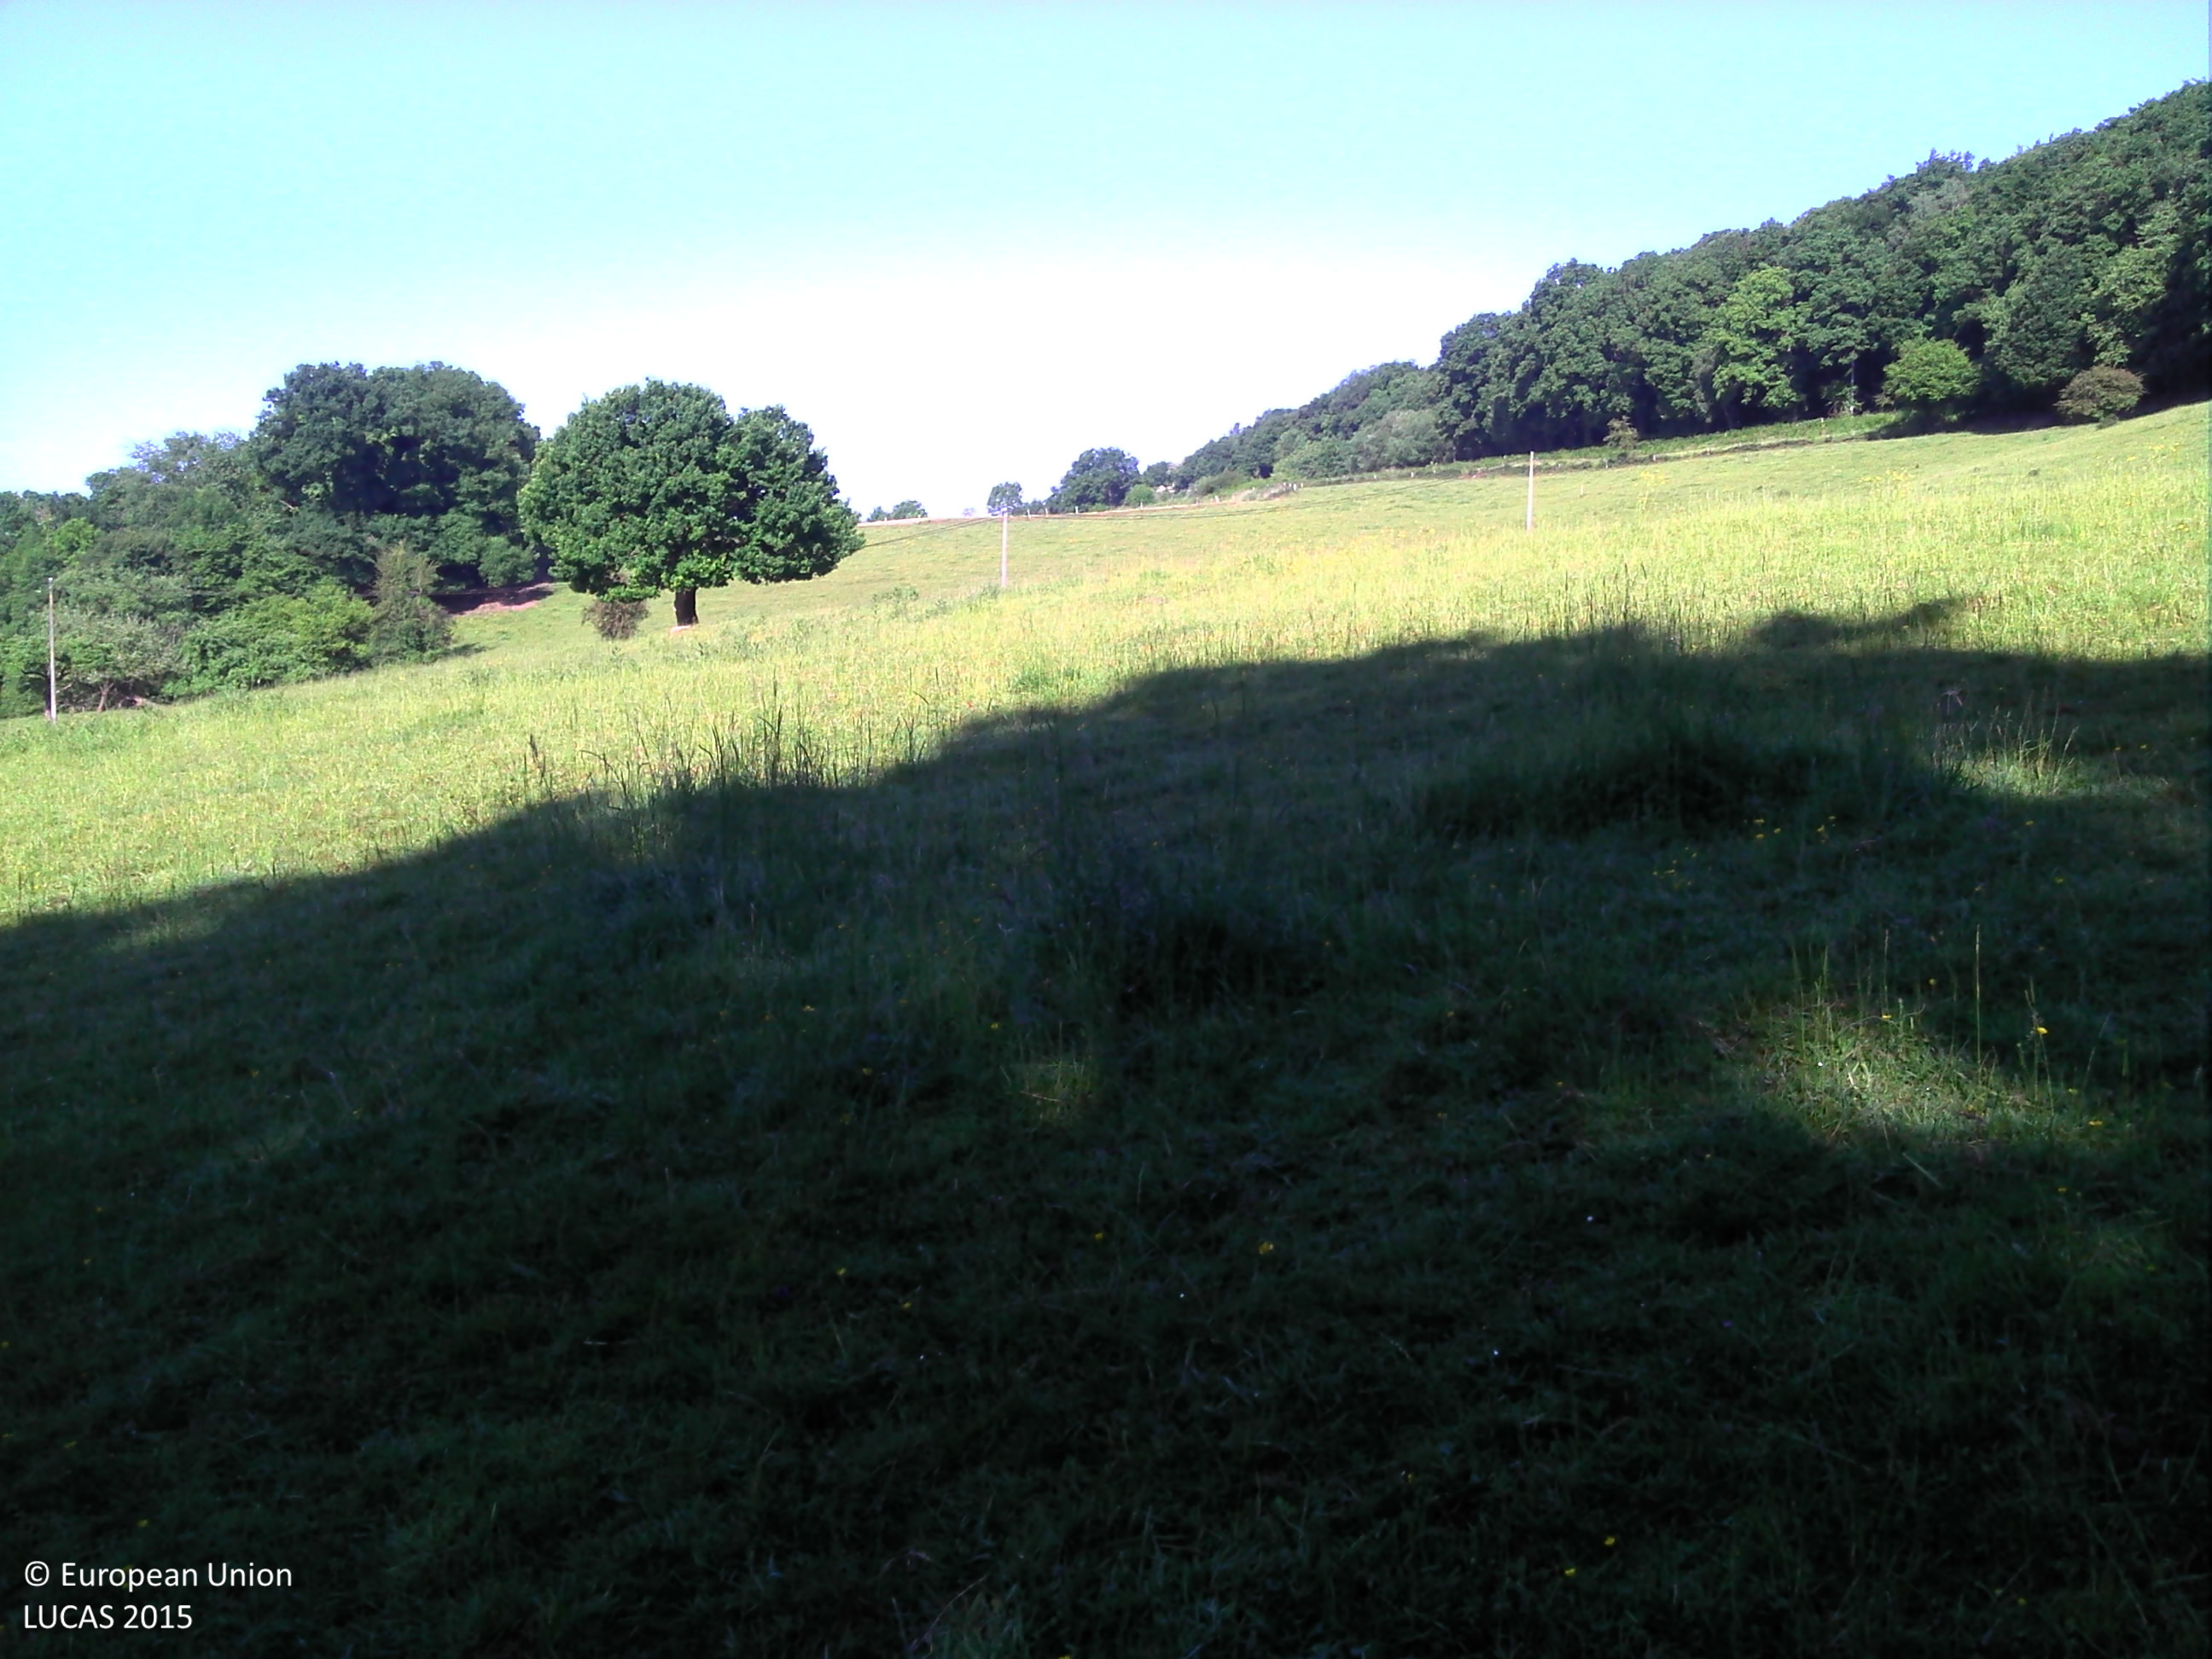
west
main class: Grassland
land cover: Grassland without tree/shrub cover
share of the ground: > 75 %
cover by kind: herbaceous plants 100 %
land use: Agriculture (excluding fallow land and kitchen gardens)
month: June
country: BE
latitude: 50.5499
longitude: 5.6092
